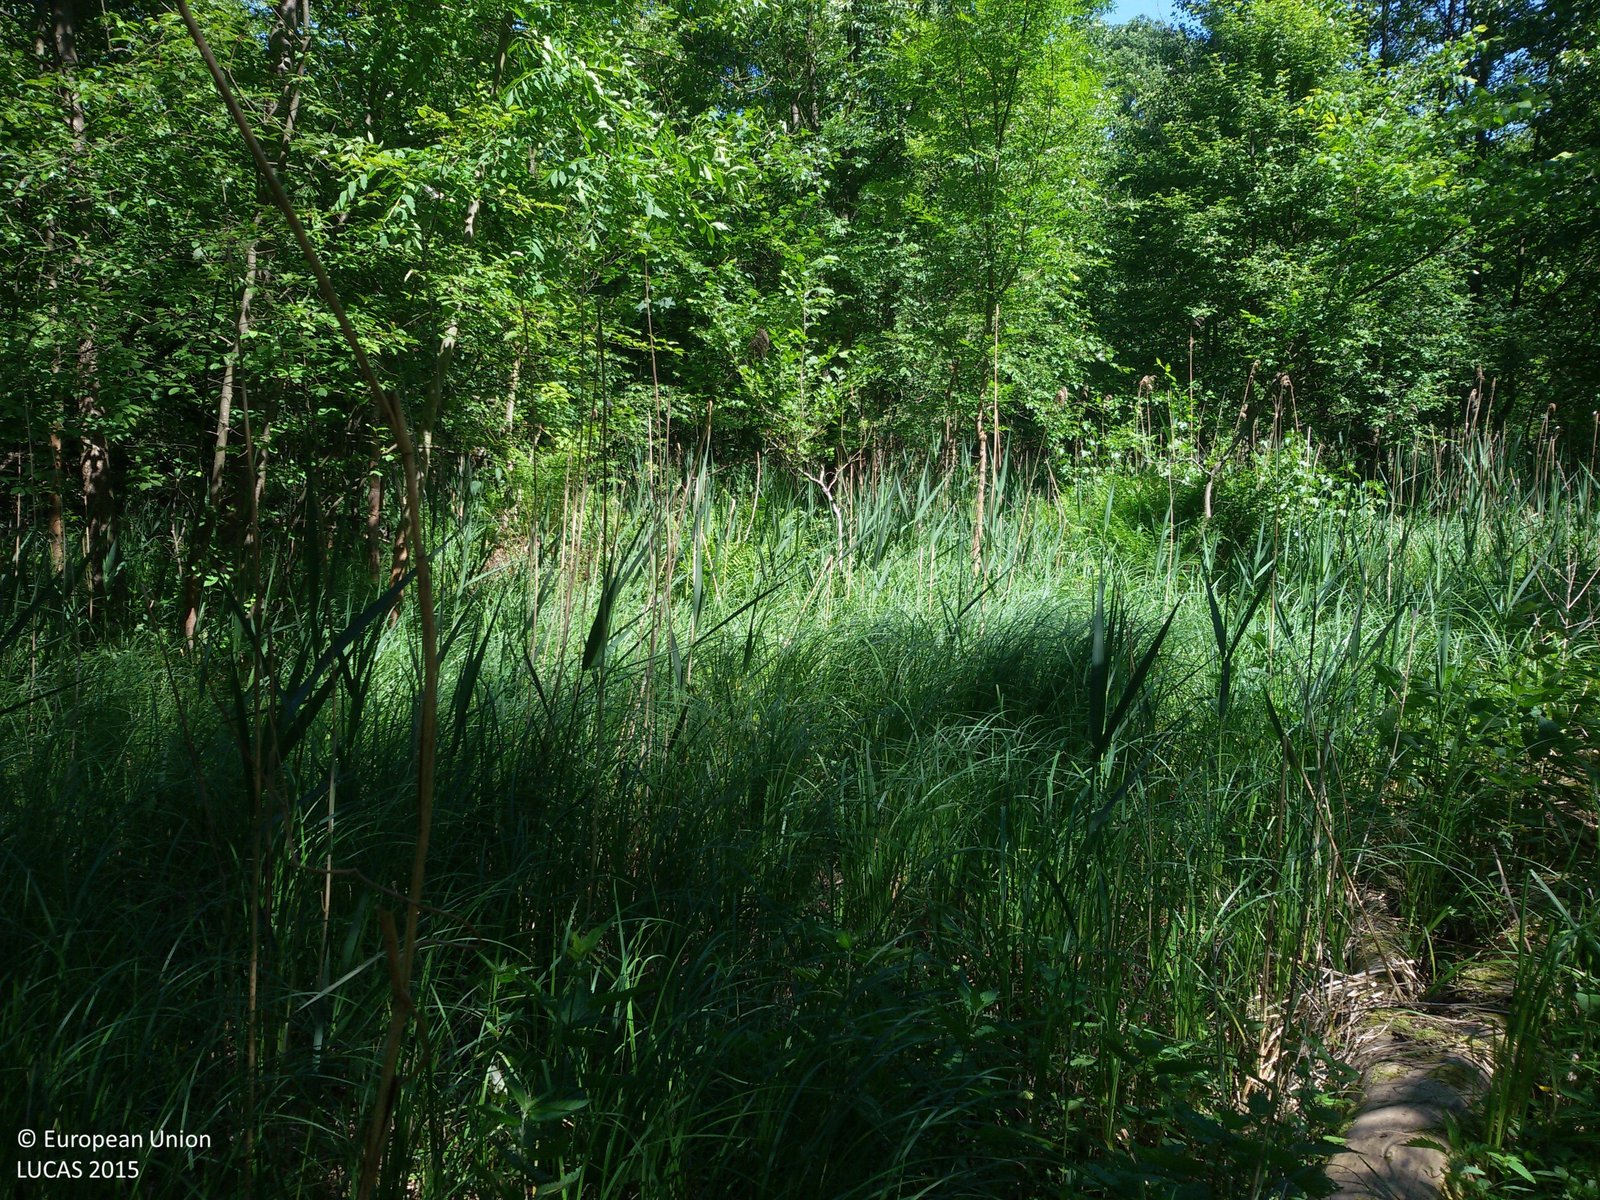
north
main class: Woodland
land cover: Broadleaved woodland
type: beech forest
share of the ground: 50 - 75 %
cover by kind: broadleaved forest trees 60 %, shrubs 20 %, herbaceous plants 20 %
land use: Forestry
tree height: > 5 m
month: June
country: PL
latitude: 53.2852
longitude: 17.0745
